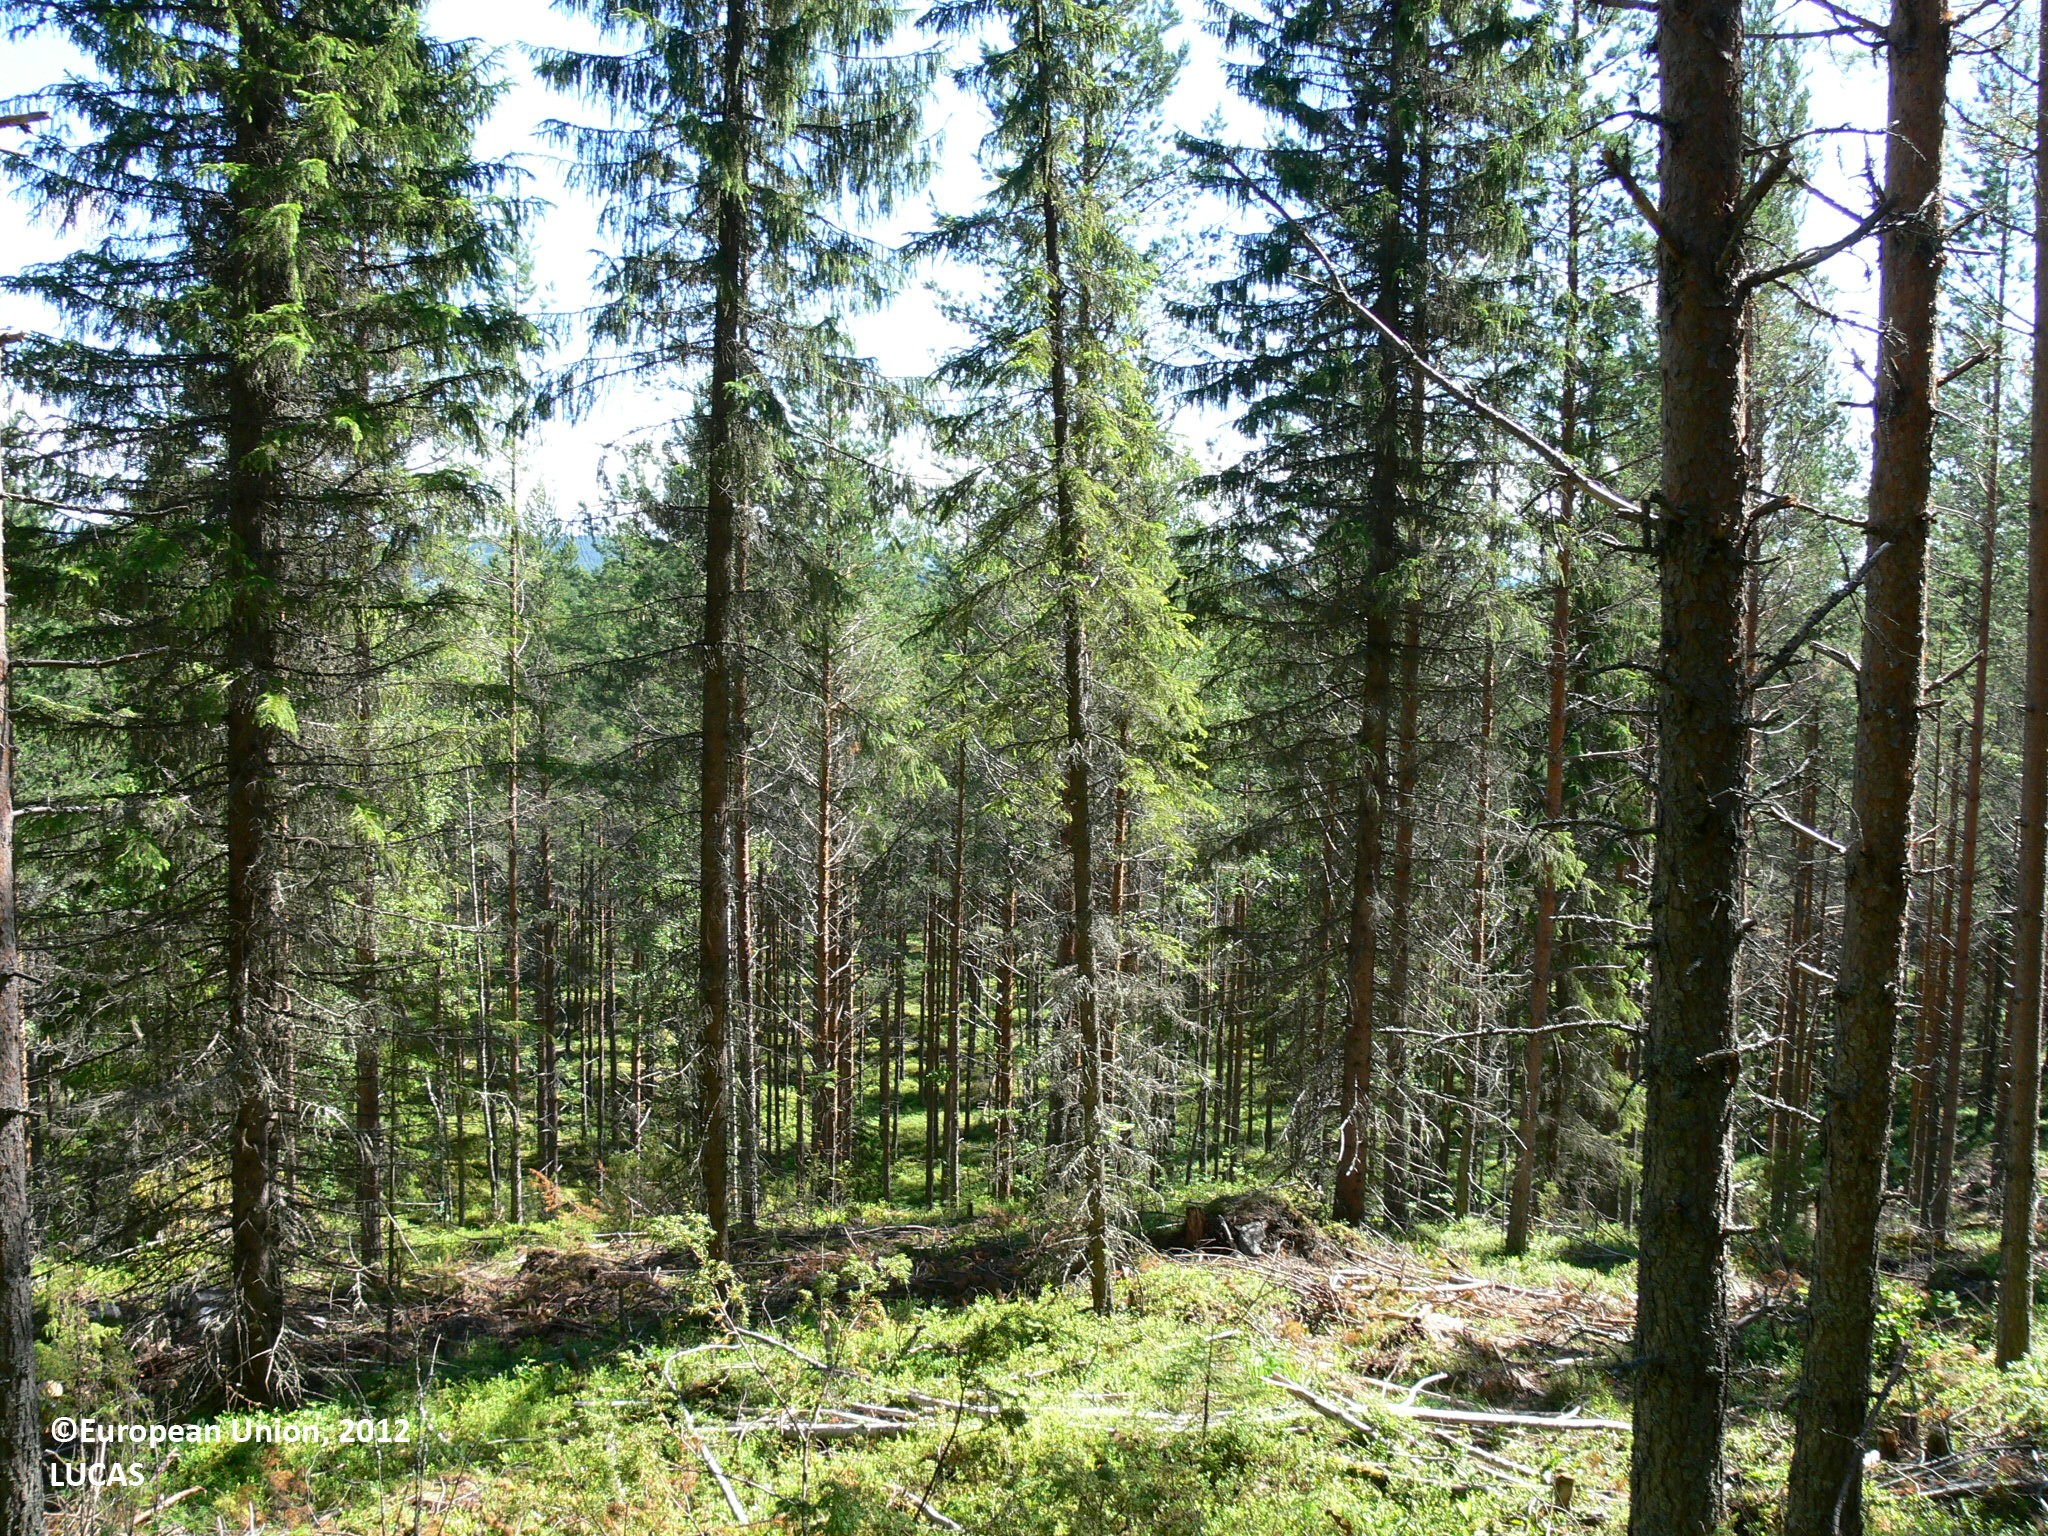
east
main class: Woodland
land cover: Other coniferous woodland
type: boreal forest
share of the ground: 50 - 75 %
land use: Forestry
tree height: > 5 m
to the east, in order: Other coniferous woodland; Pine dominated coniferous woodland; Tracks; Pine dominated coniferous woodland; Tracks; Pine dominated coniferous woodland; Other mixed woodland
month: July
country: FI
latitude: 62.9704
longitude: 29.9980
